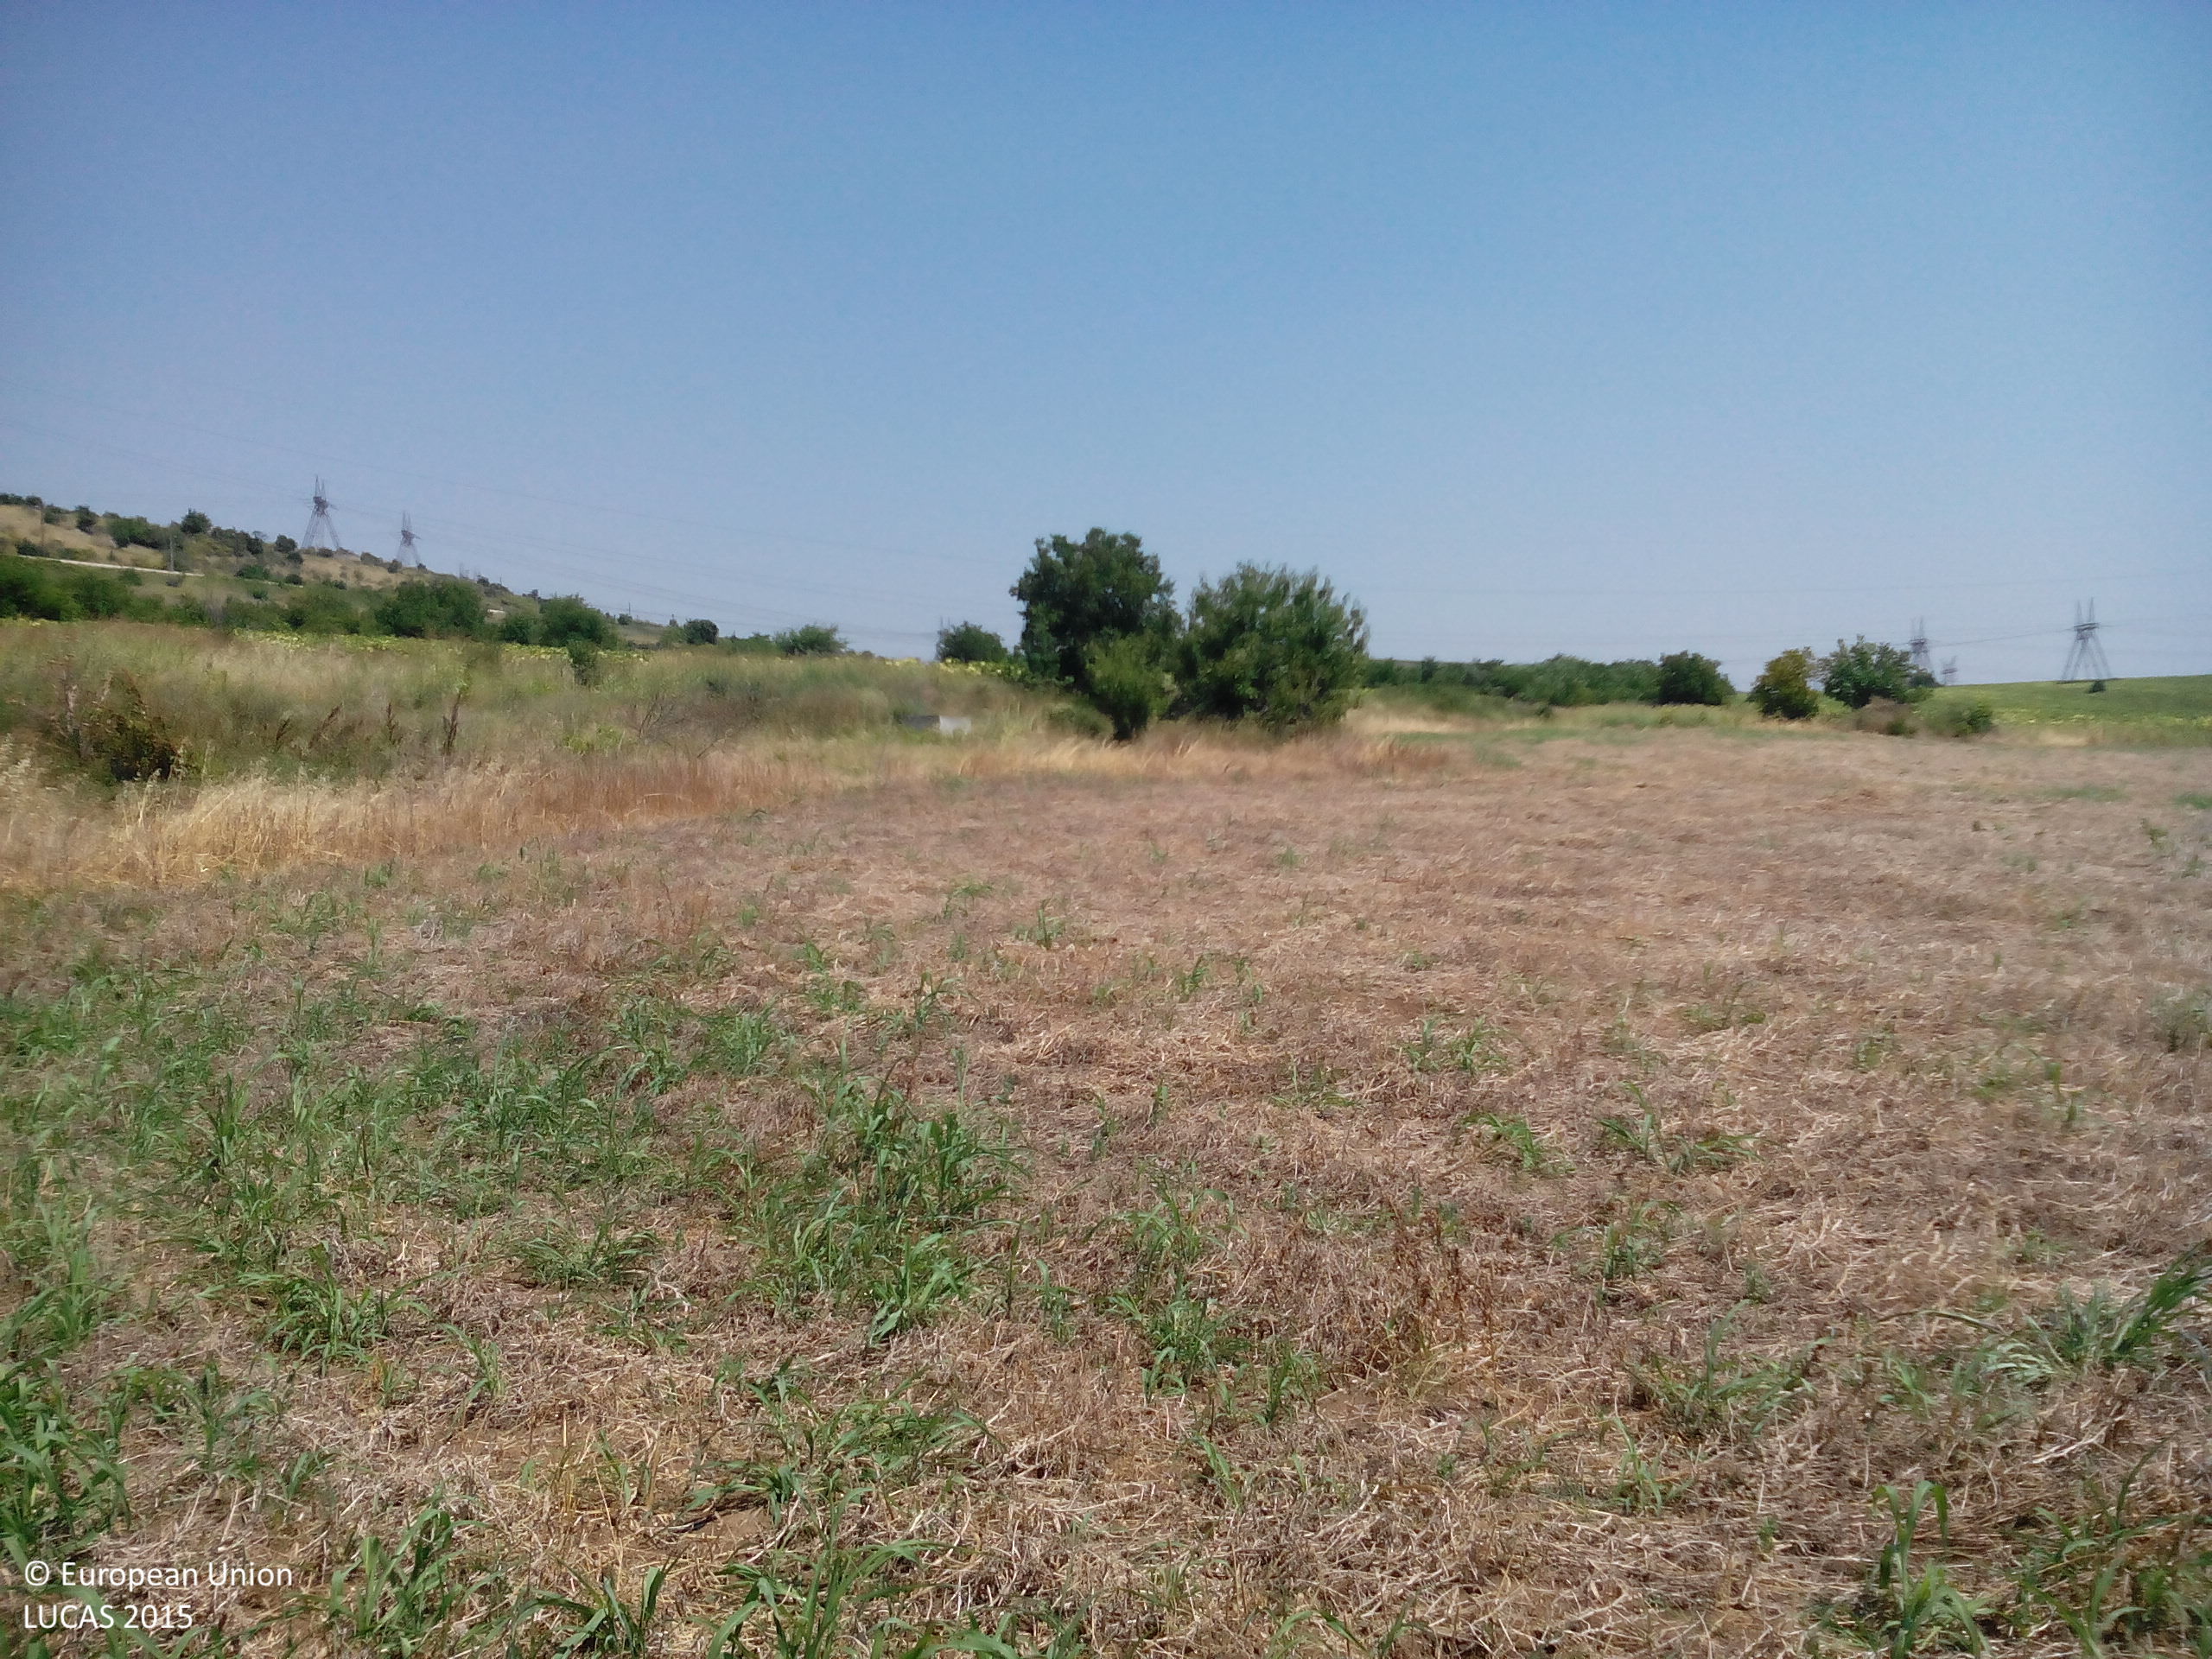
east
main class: Cropland
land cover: Dry pulses
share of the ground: 25 - 50 %
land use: Agriculture (excluding fallow land and kitchen gardens)
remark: Harvested field
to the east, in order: Tracks; Dry pulses; Shrubland with sparse tree cover; Tracks; Single bushes/trees; Sunflower; Shrubland with sparse tree cover
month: July
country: BG
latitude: 43.2819
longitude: 24.1635
